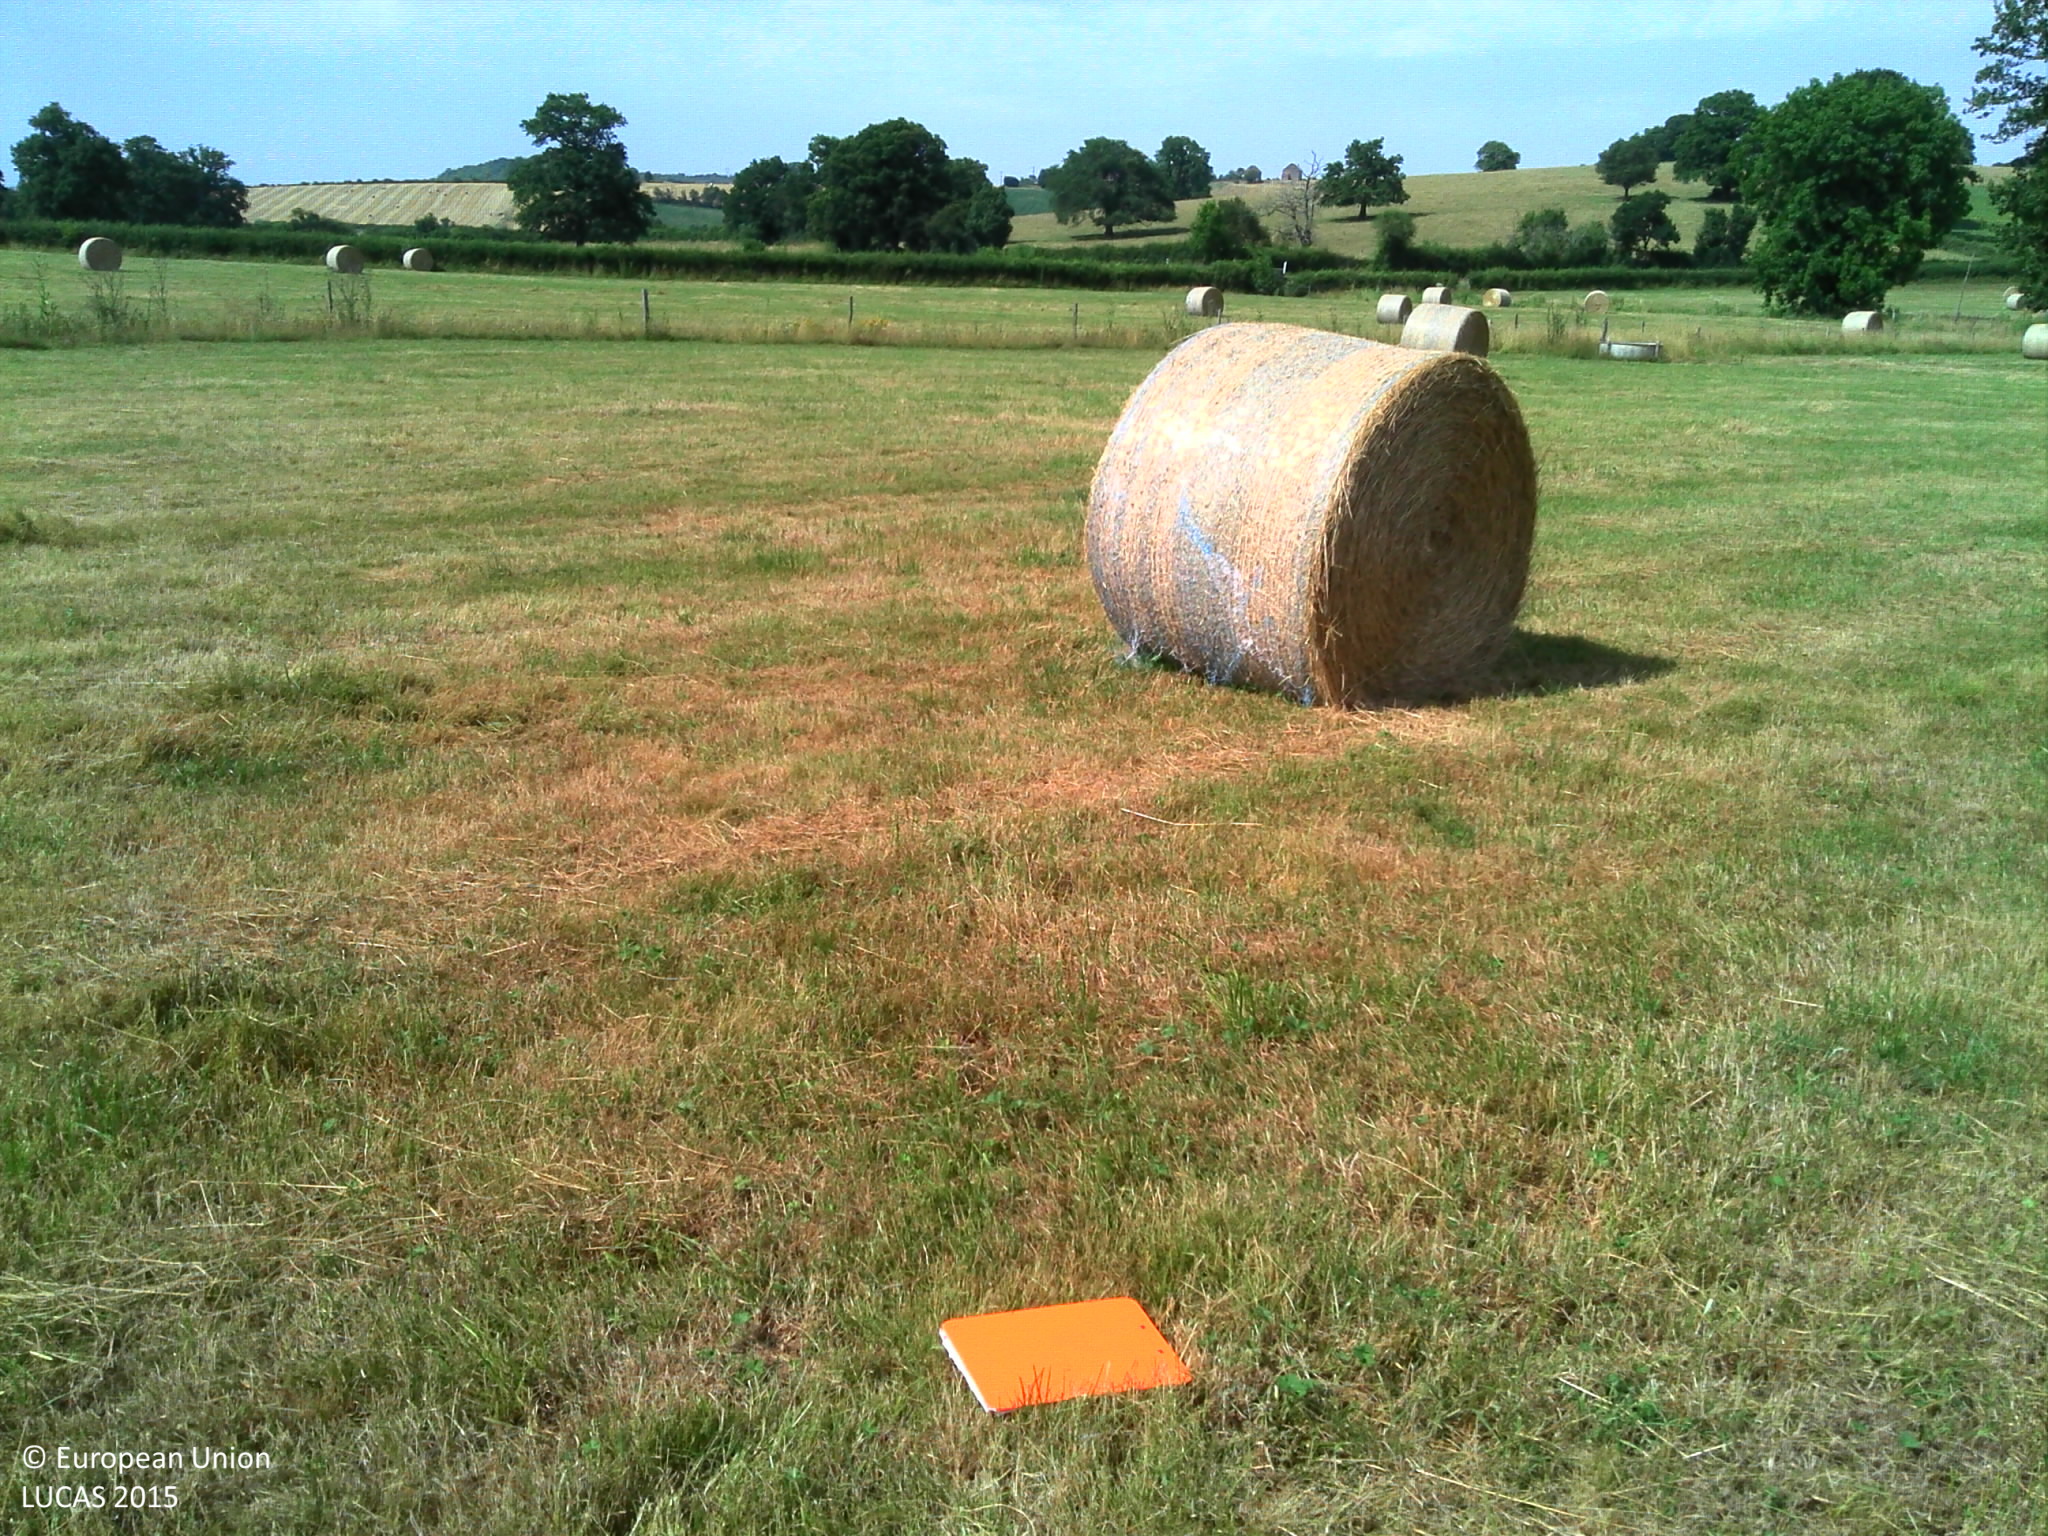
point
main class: Grassland
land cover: Grassland without tree/shrub cover
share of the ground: > 75 %
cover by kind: herbaceous plants 100 %
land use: Agriculture (excluding fallow land and kitchen gardens)
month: July
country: FR
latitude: 47.2379
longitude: 3.5109
